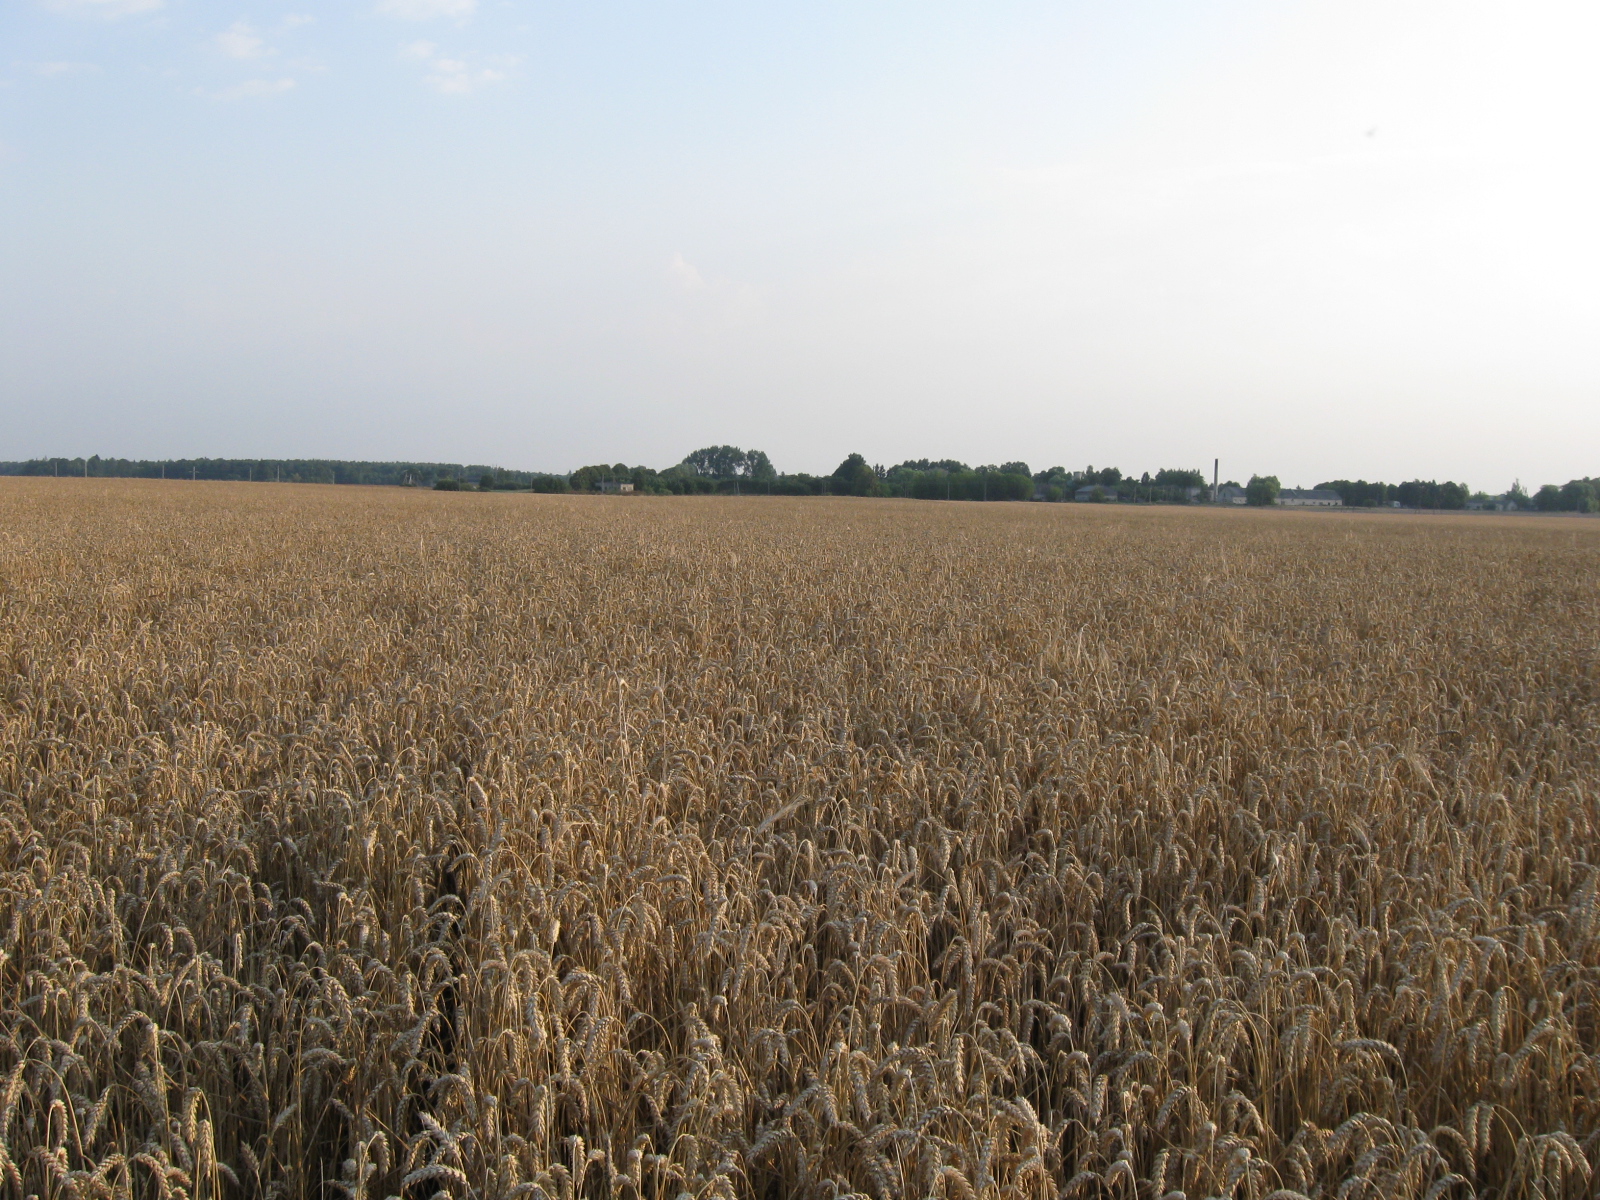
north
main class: Cropland
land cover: Common wheat
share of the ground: > 75 %
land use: Agriculture (excluding fallow land and kitchen gardens)
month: August
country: LT
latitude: 54.5784
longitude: 23.3057
